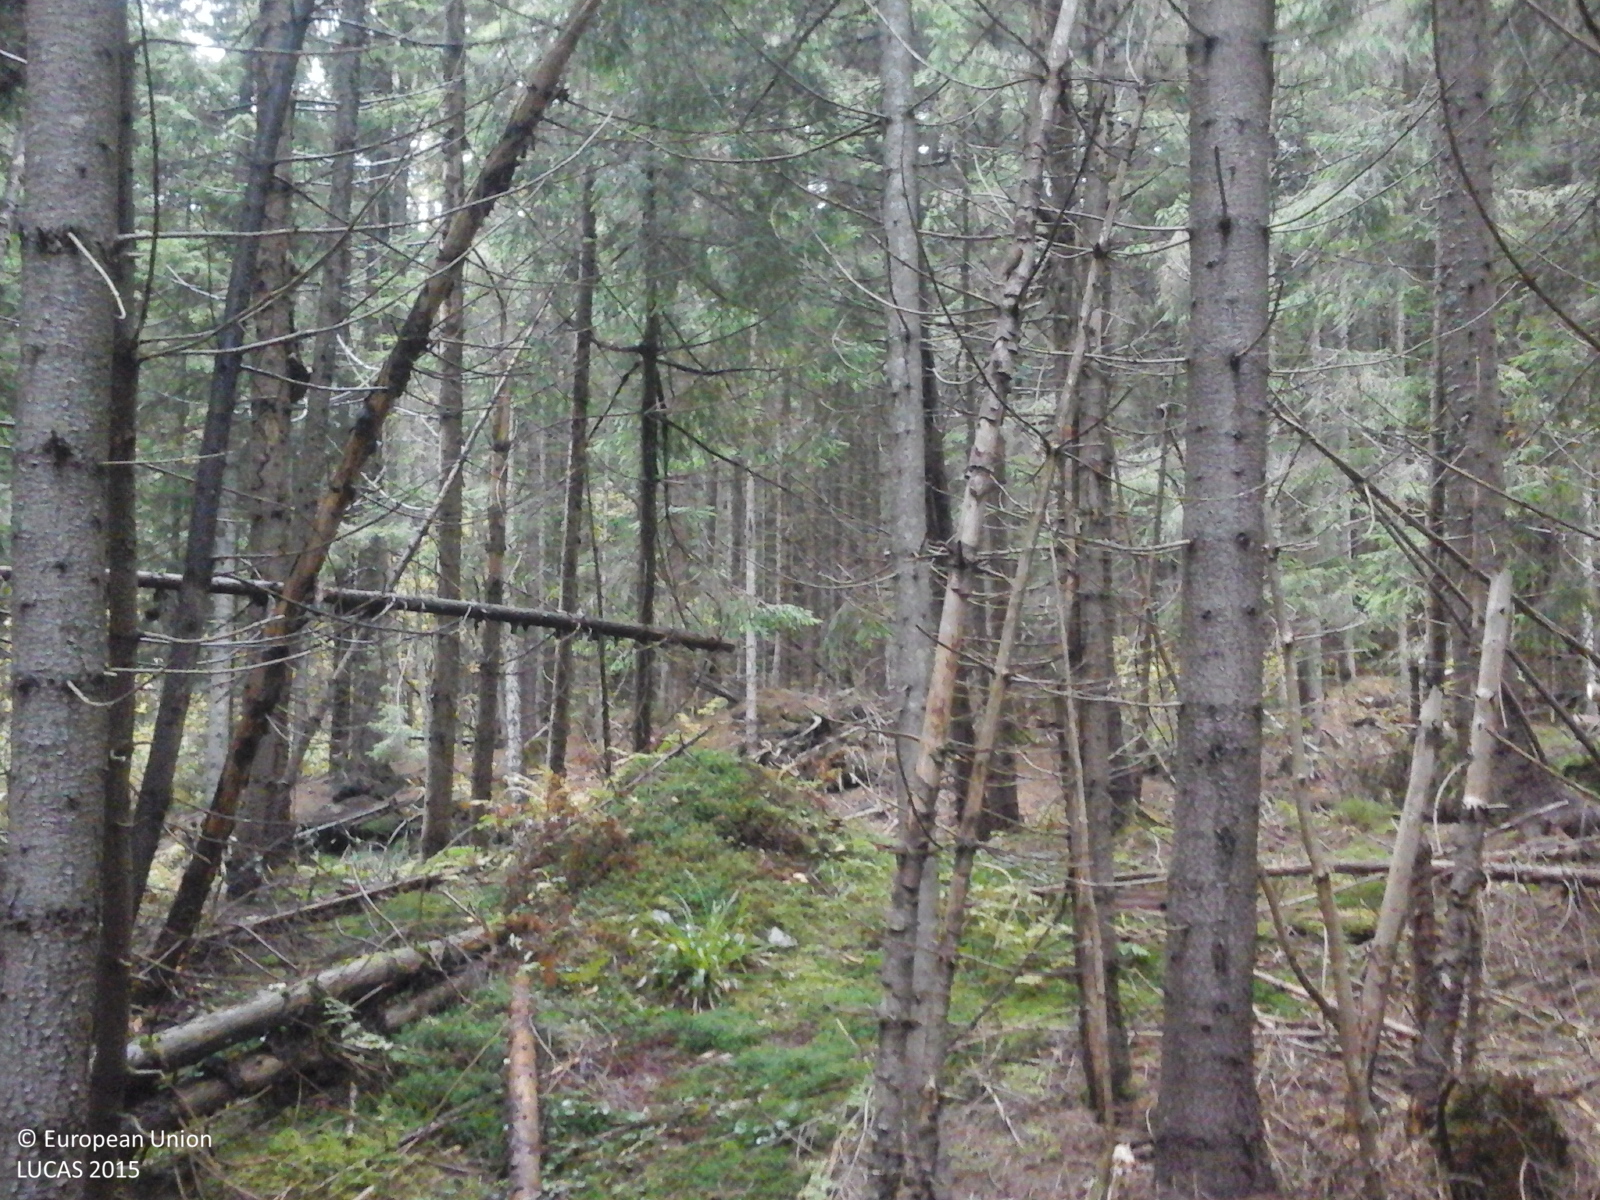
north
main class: Woodland
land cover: Spruce dominated coniferous woodland
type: alpine coniferous forest
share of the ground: > 75 %
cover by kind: coniferous forest trees 100 %
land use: Forestry
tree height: > 5 m
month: October
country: RO
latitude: 46.8291
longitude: 25.2200
